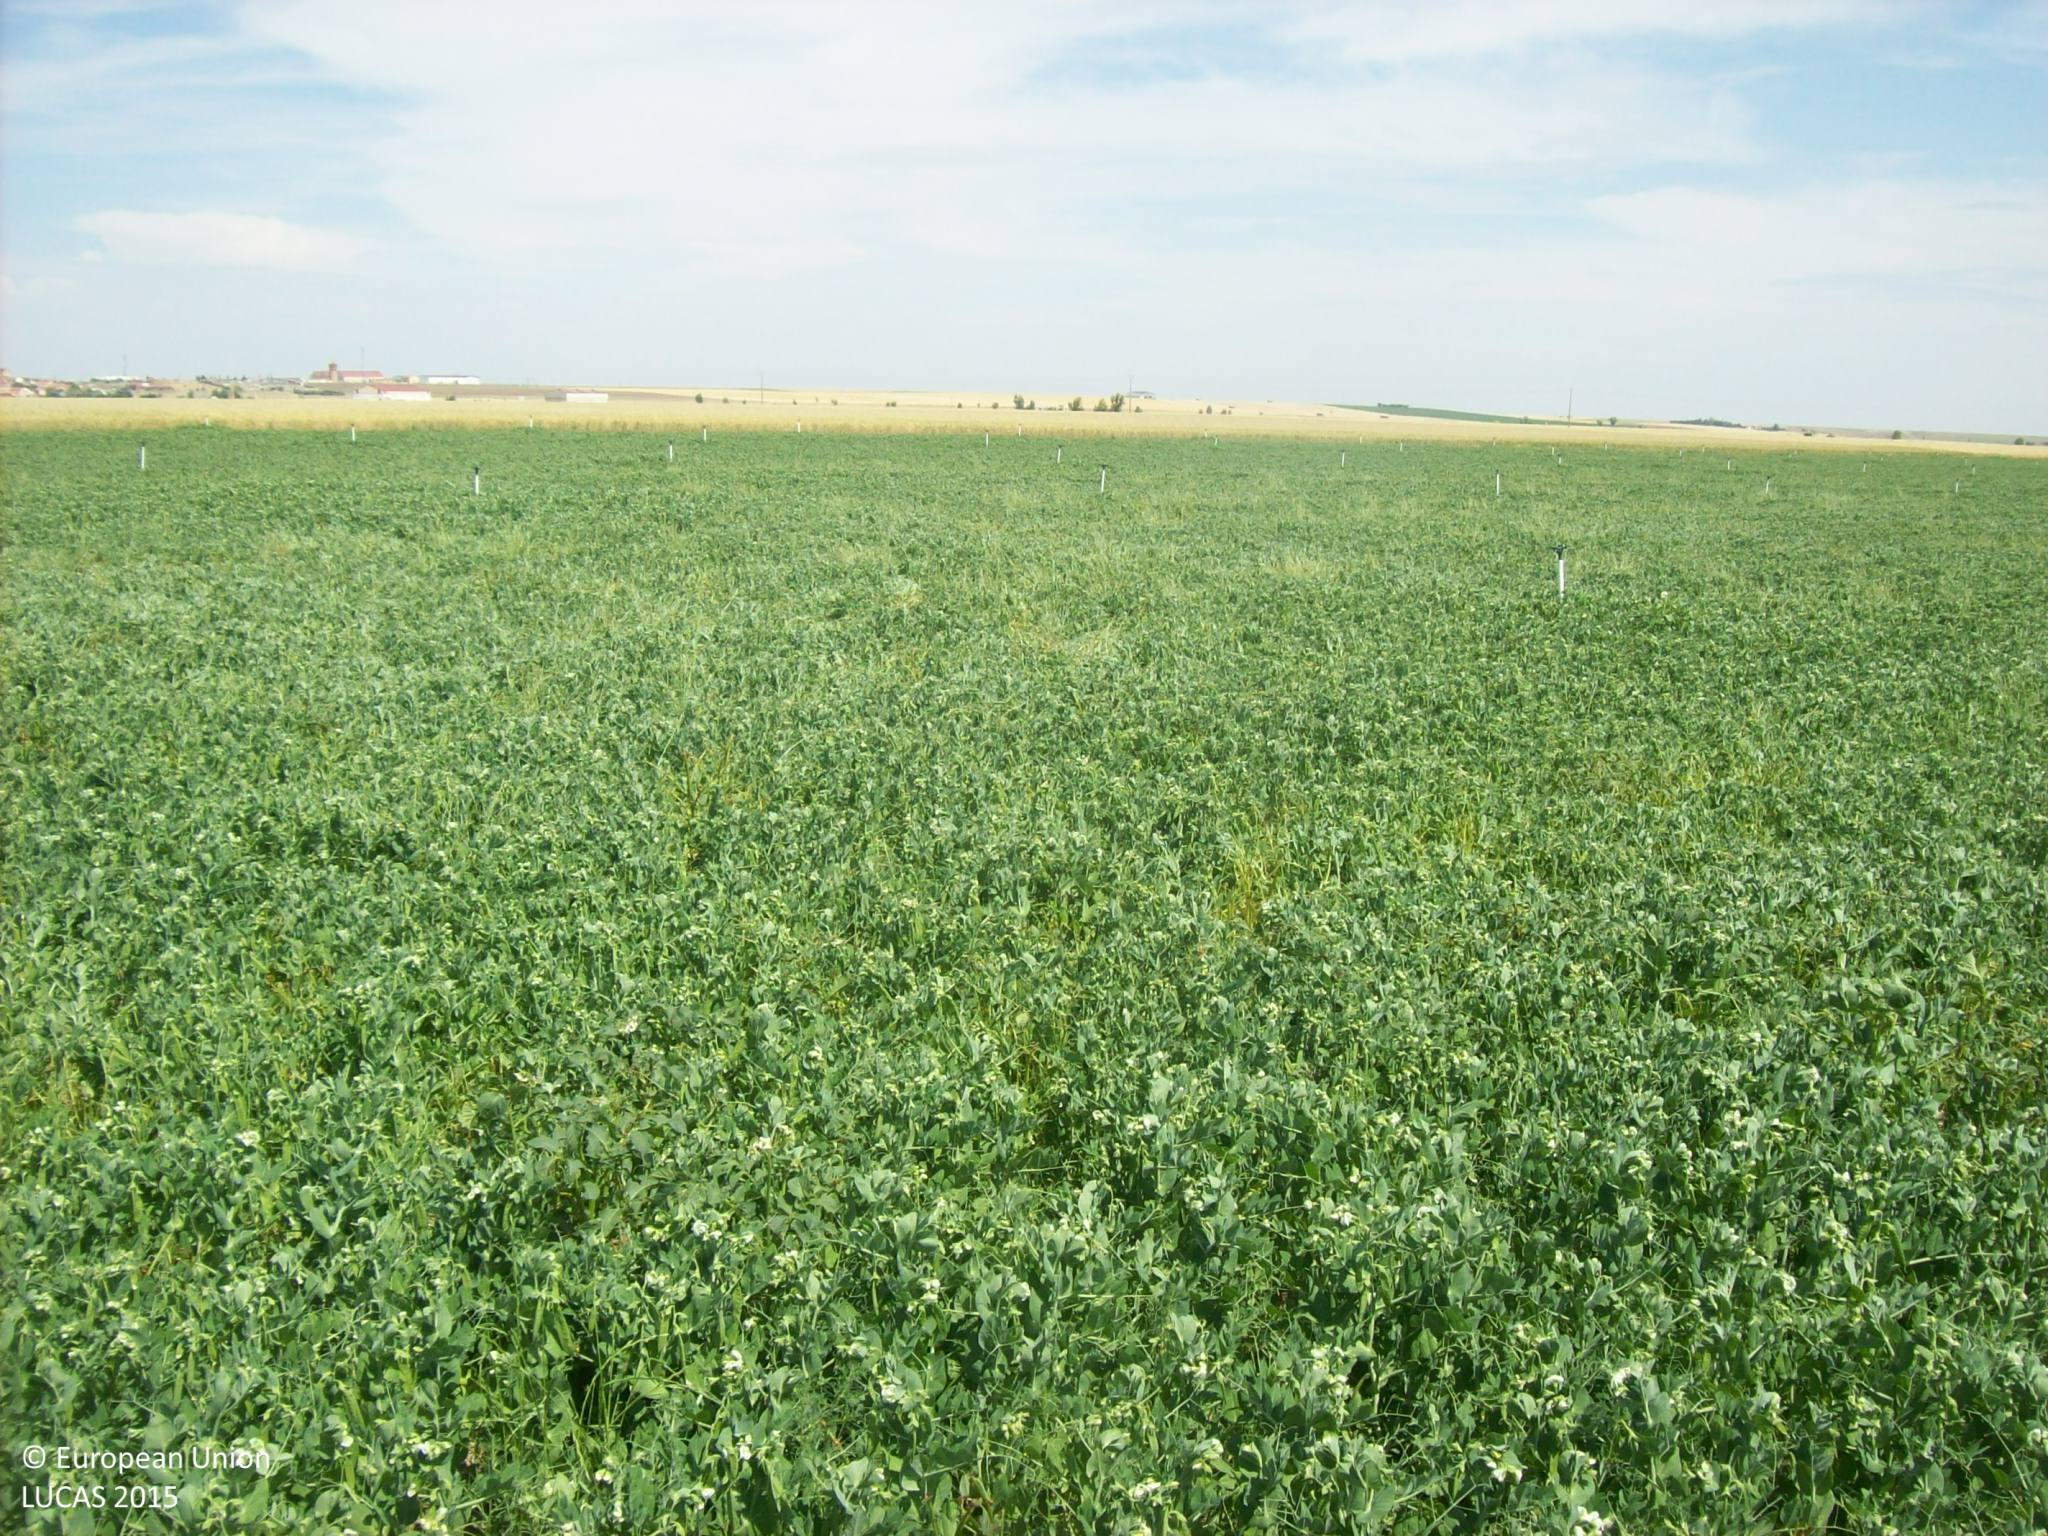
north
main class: Cropland
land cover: Dry pulses
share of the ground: > 75 %
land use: Agriculture (excluding fallow land and kitchen gardens)
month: June
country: ES
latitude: 41.0743
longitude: -4.9790
